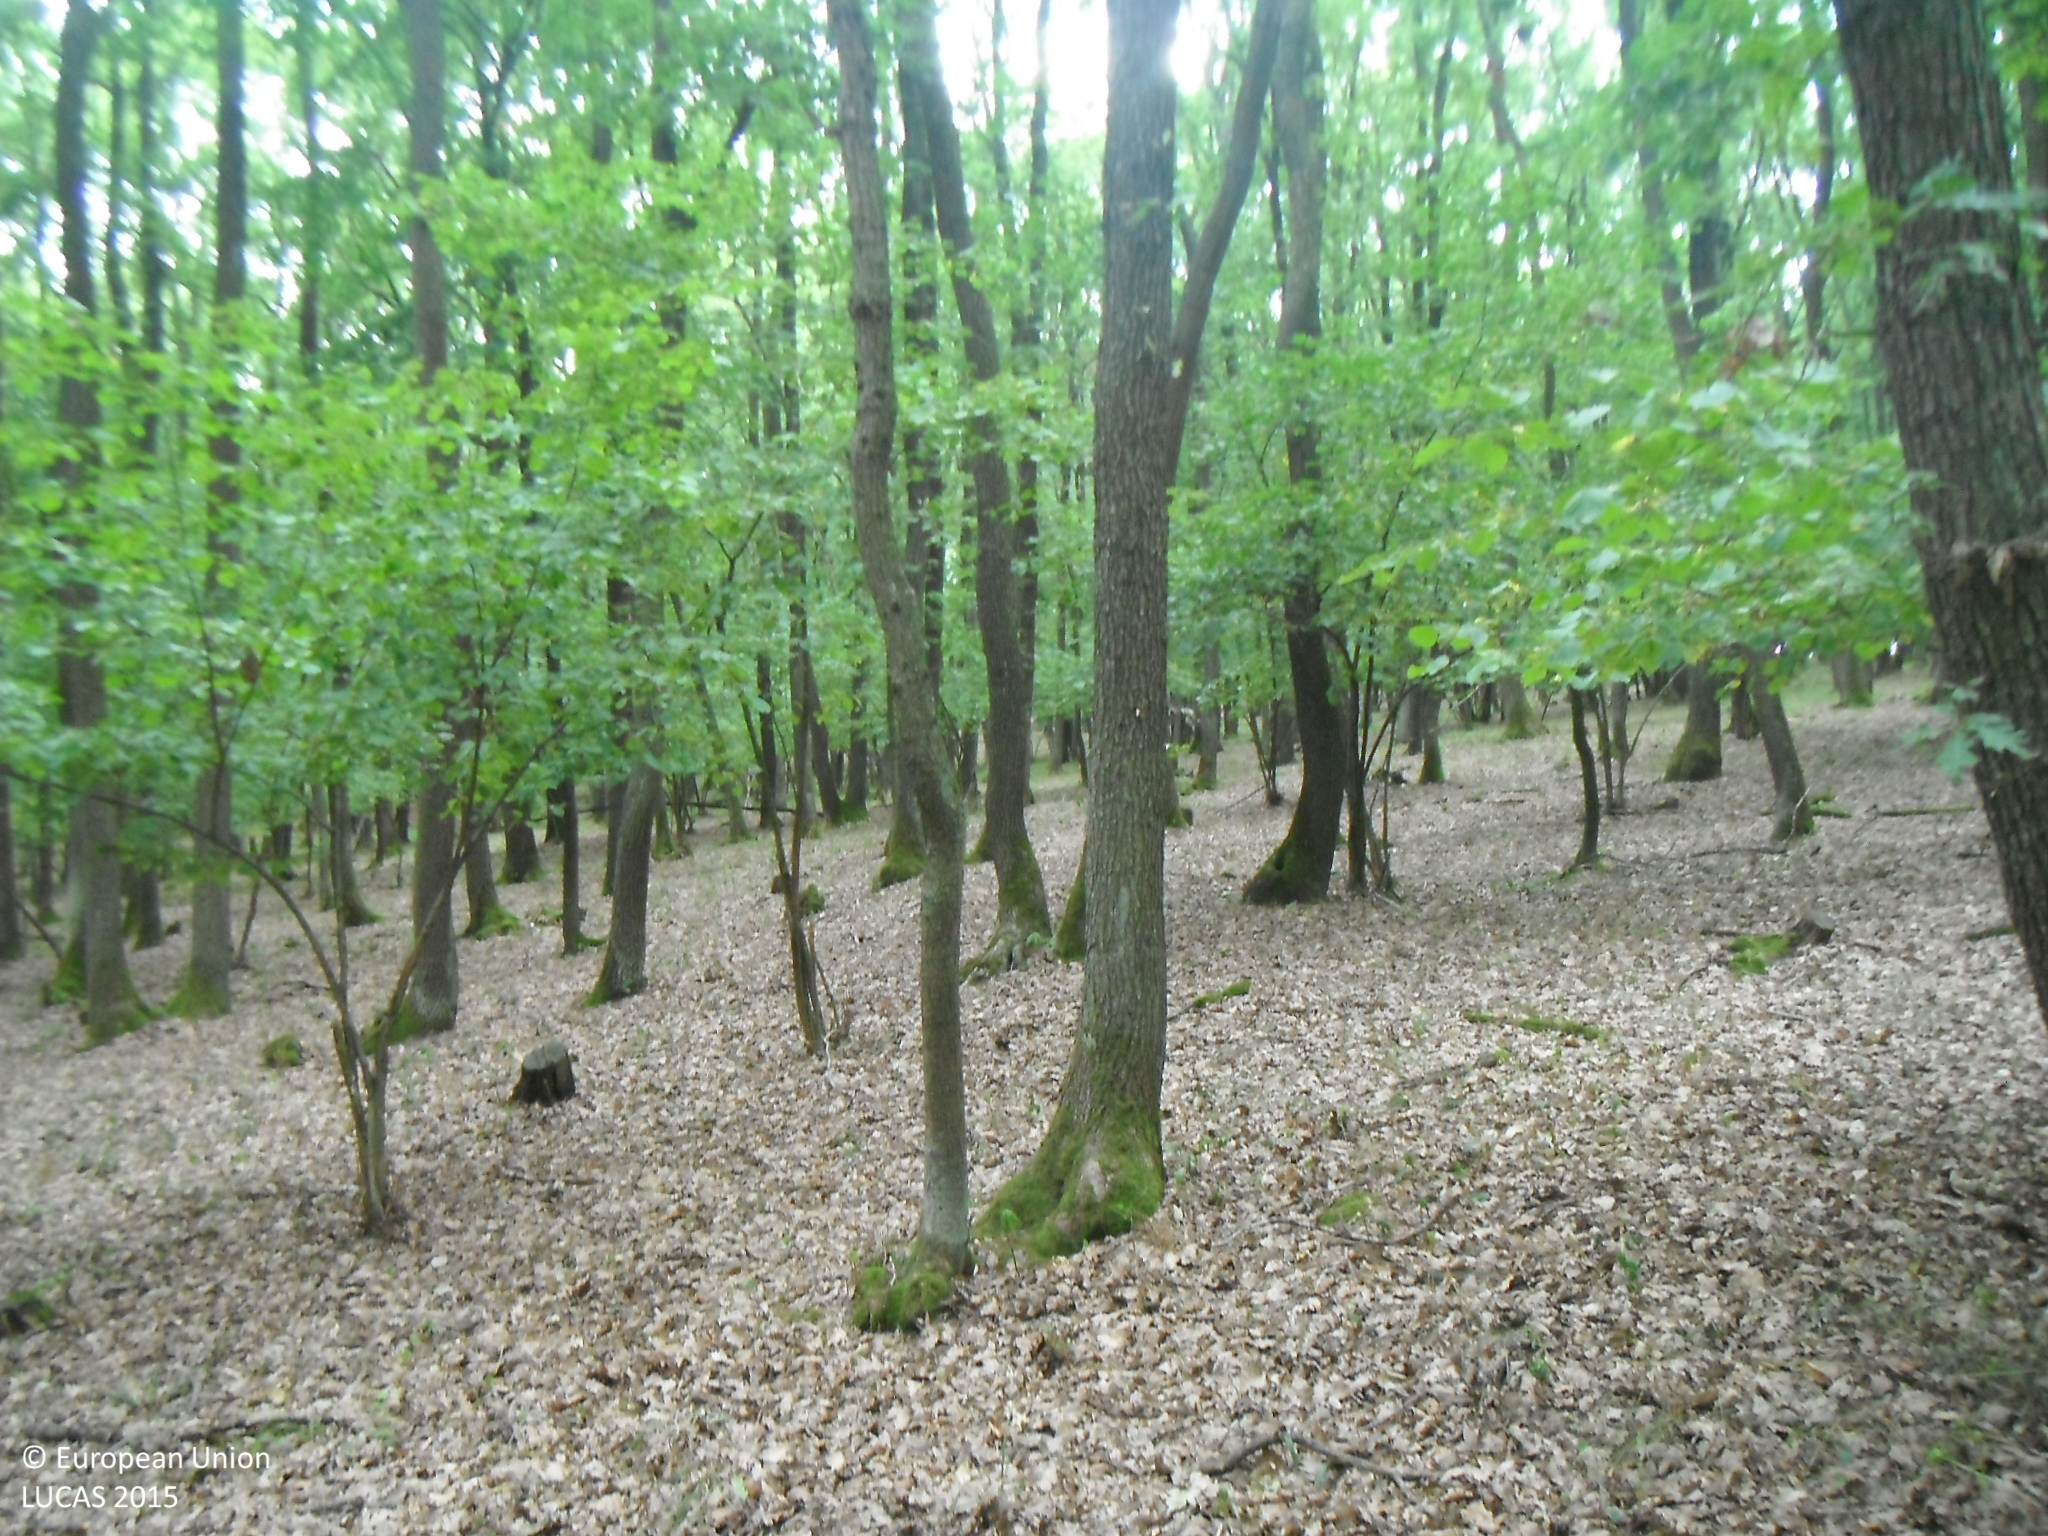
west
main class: Woodland
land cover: Broadleaved woodland
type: mesophytic deciduous forest
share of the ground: > 75 %
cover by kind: broadleaved forest trees 90 %, herbaceous plants 5 %, unconsolidated bare surface 5 %
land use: Forestry
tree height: > 5 m
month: July
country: SK
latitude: 48.7965
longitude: 17.2659
